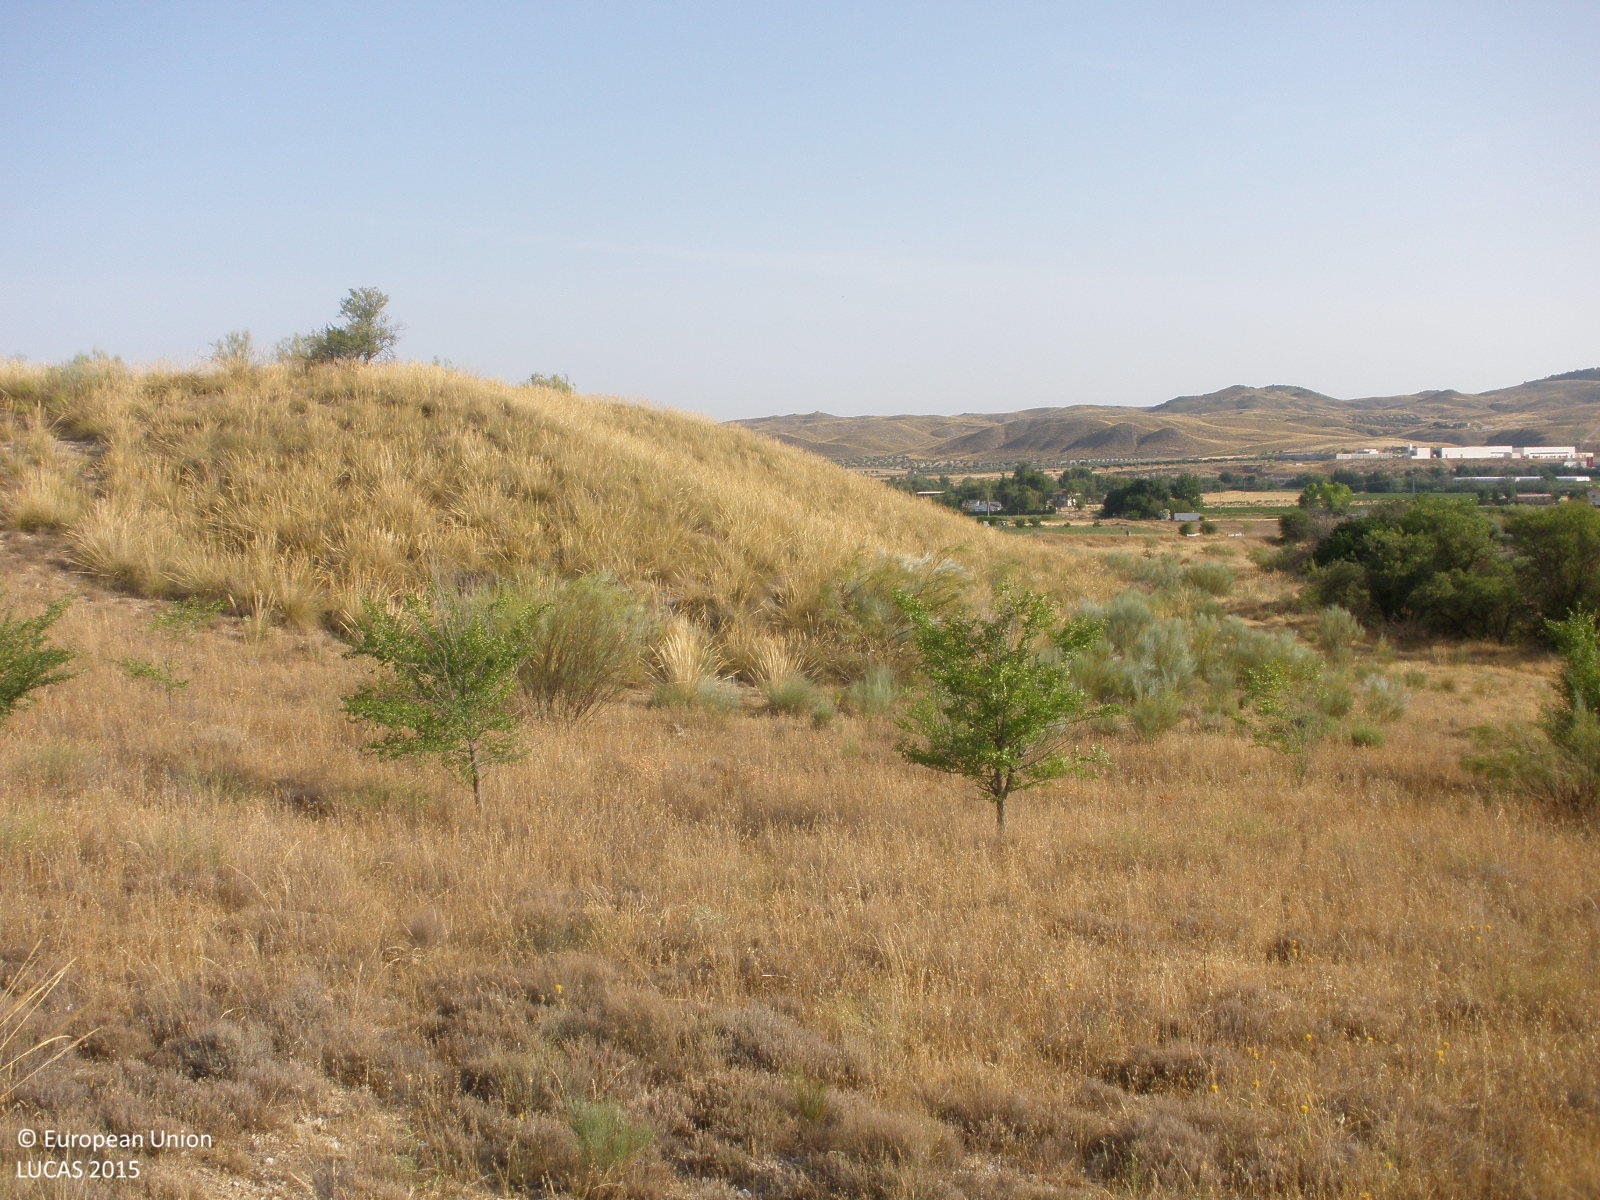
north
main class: Shrubland
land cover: Shrubland without tree cover
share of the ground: 25 - 50 %
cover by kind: herbaceous plants 60 %, shrubs 30 %, consolidated bare surface 10 %
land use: Semi-natural and natural areas not in use
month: July
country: ES
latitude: 40.0360
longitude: -3.4243
